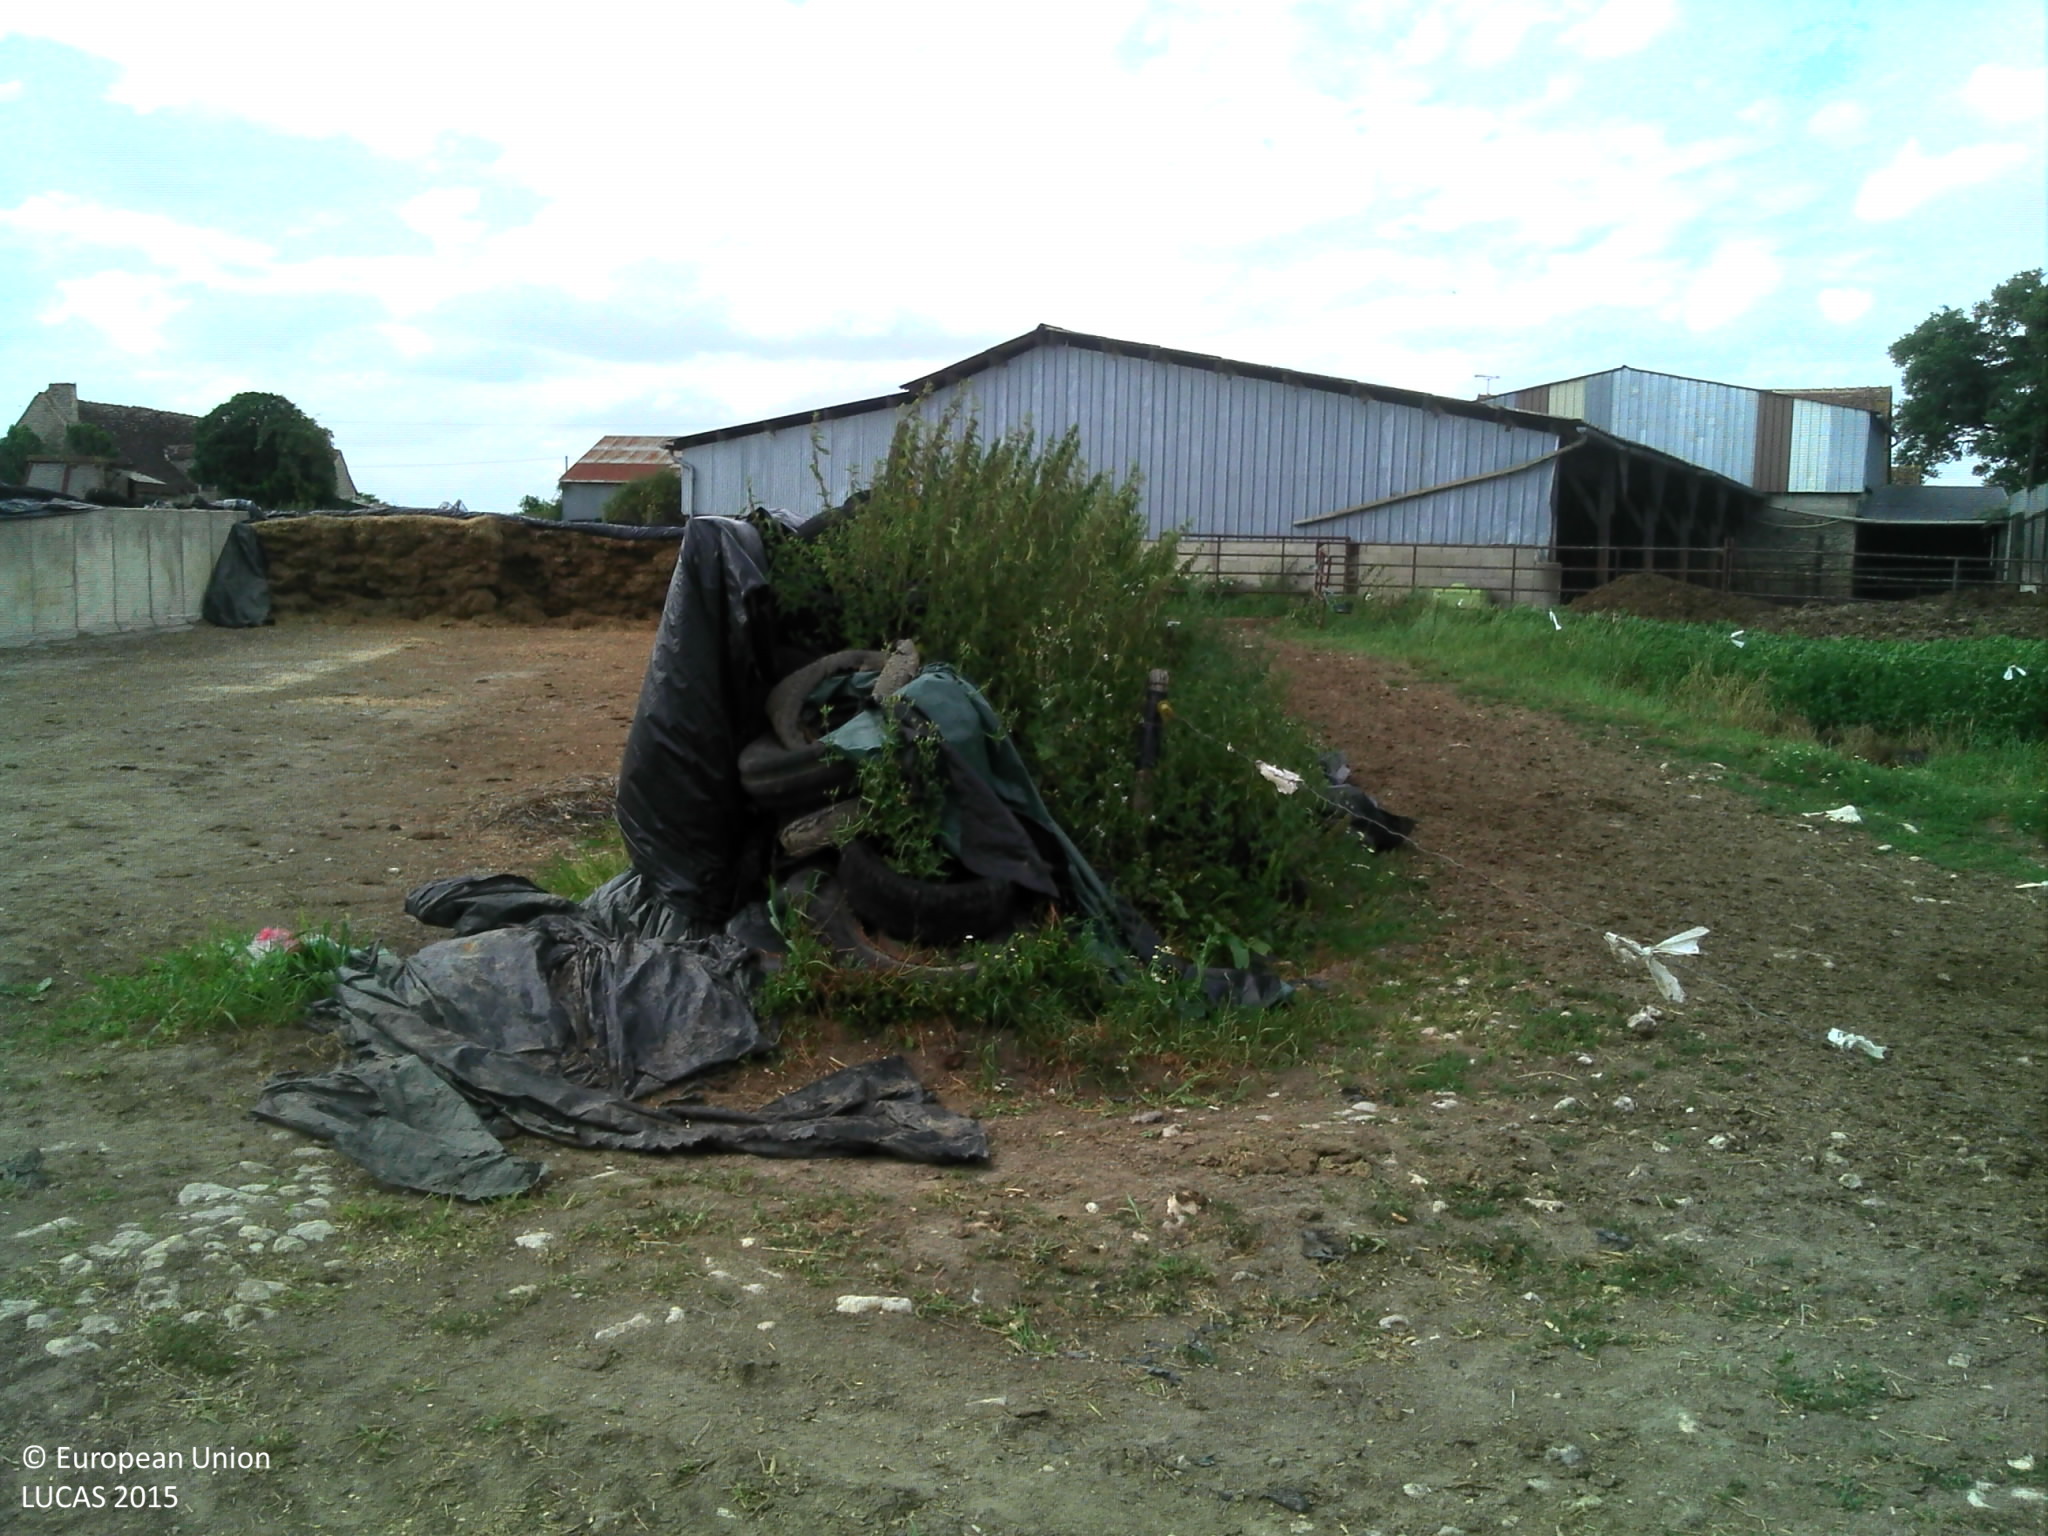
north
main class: Grassland
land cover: Grassland without tree/shrub cover
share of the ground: > 75 %
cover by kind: herbaceous plants 100 %
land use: Agriculture (excluding fallow land and kitchen gardens)
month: July
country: FR
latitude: 46.9929
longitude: 0.8710
